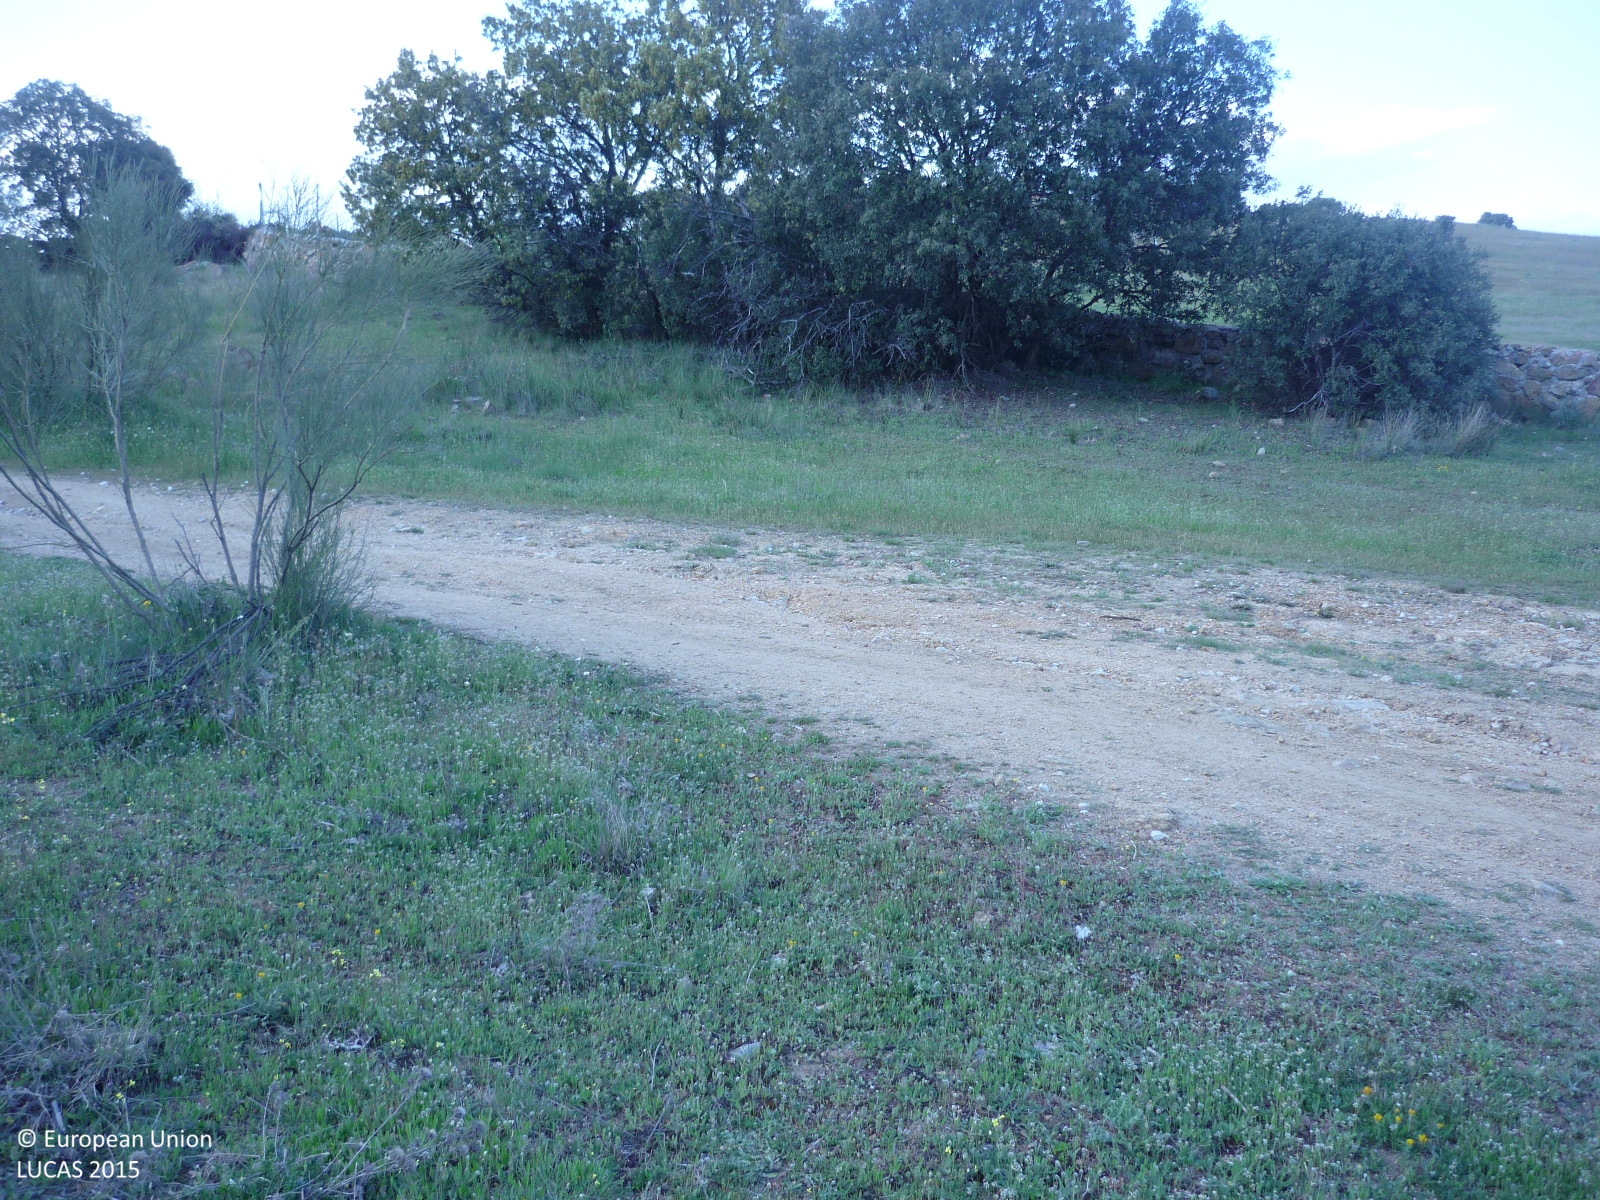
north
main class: Grassland
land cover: Grassland with sparse tree/shrub cover
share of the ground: > 75 %
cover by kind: herbaceous plants 85 %, shrubs 10 %, broadleaved forest trees 5 %
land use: Agriculture (excluding fallow land and kitchen gardens)
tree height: > 5 m
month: April
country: ES
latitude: 40.7794
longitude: -3.6081
